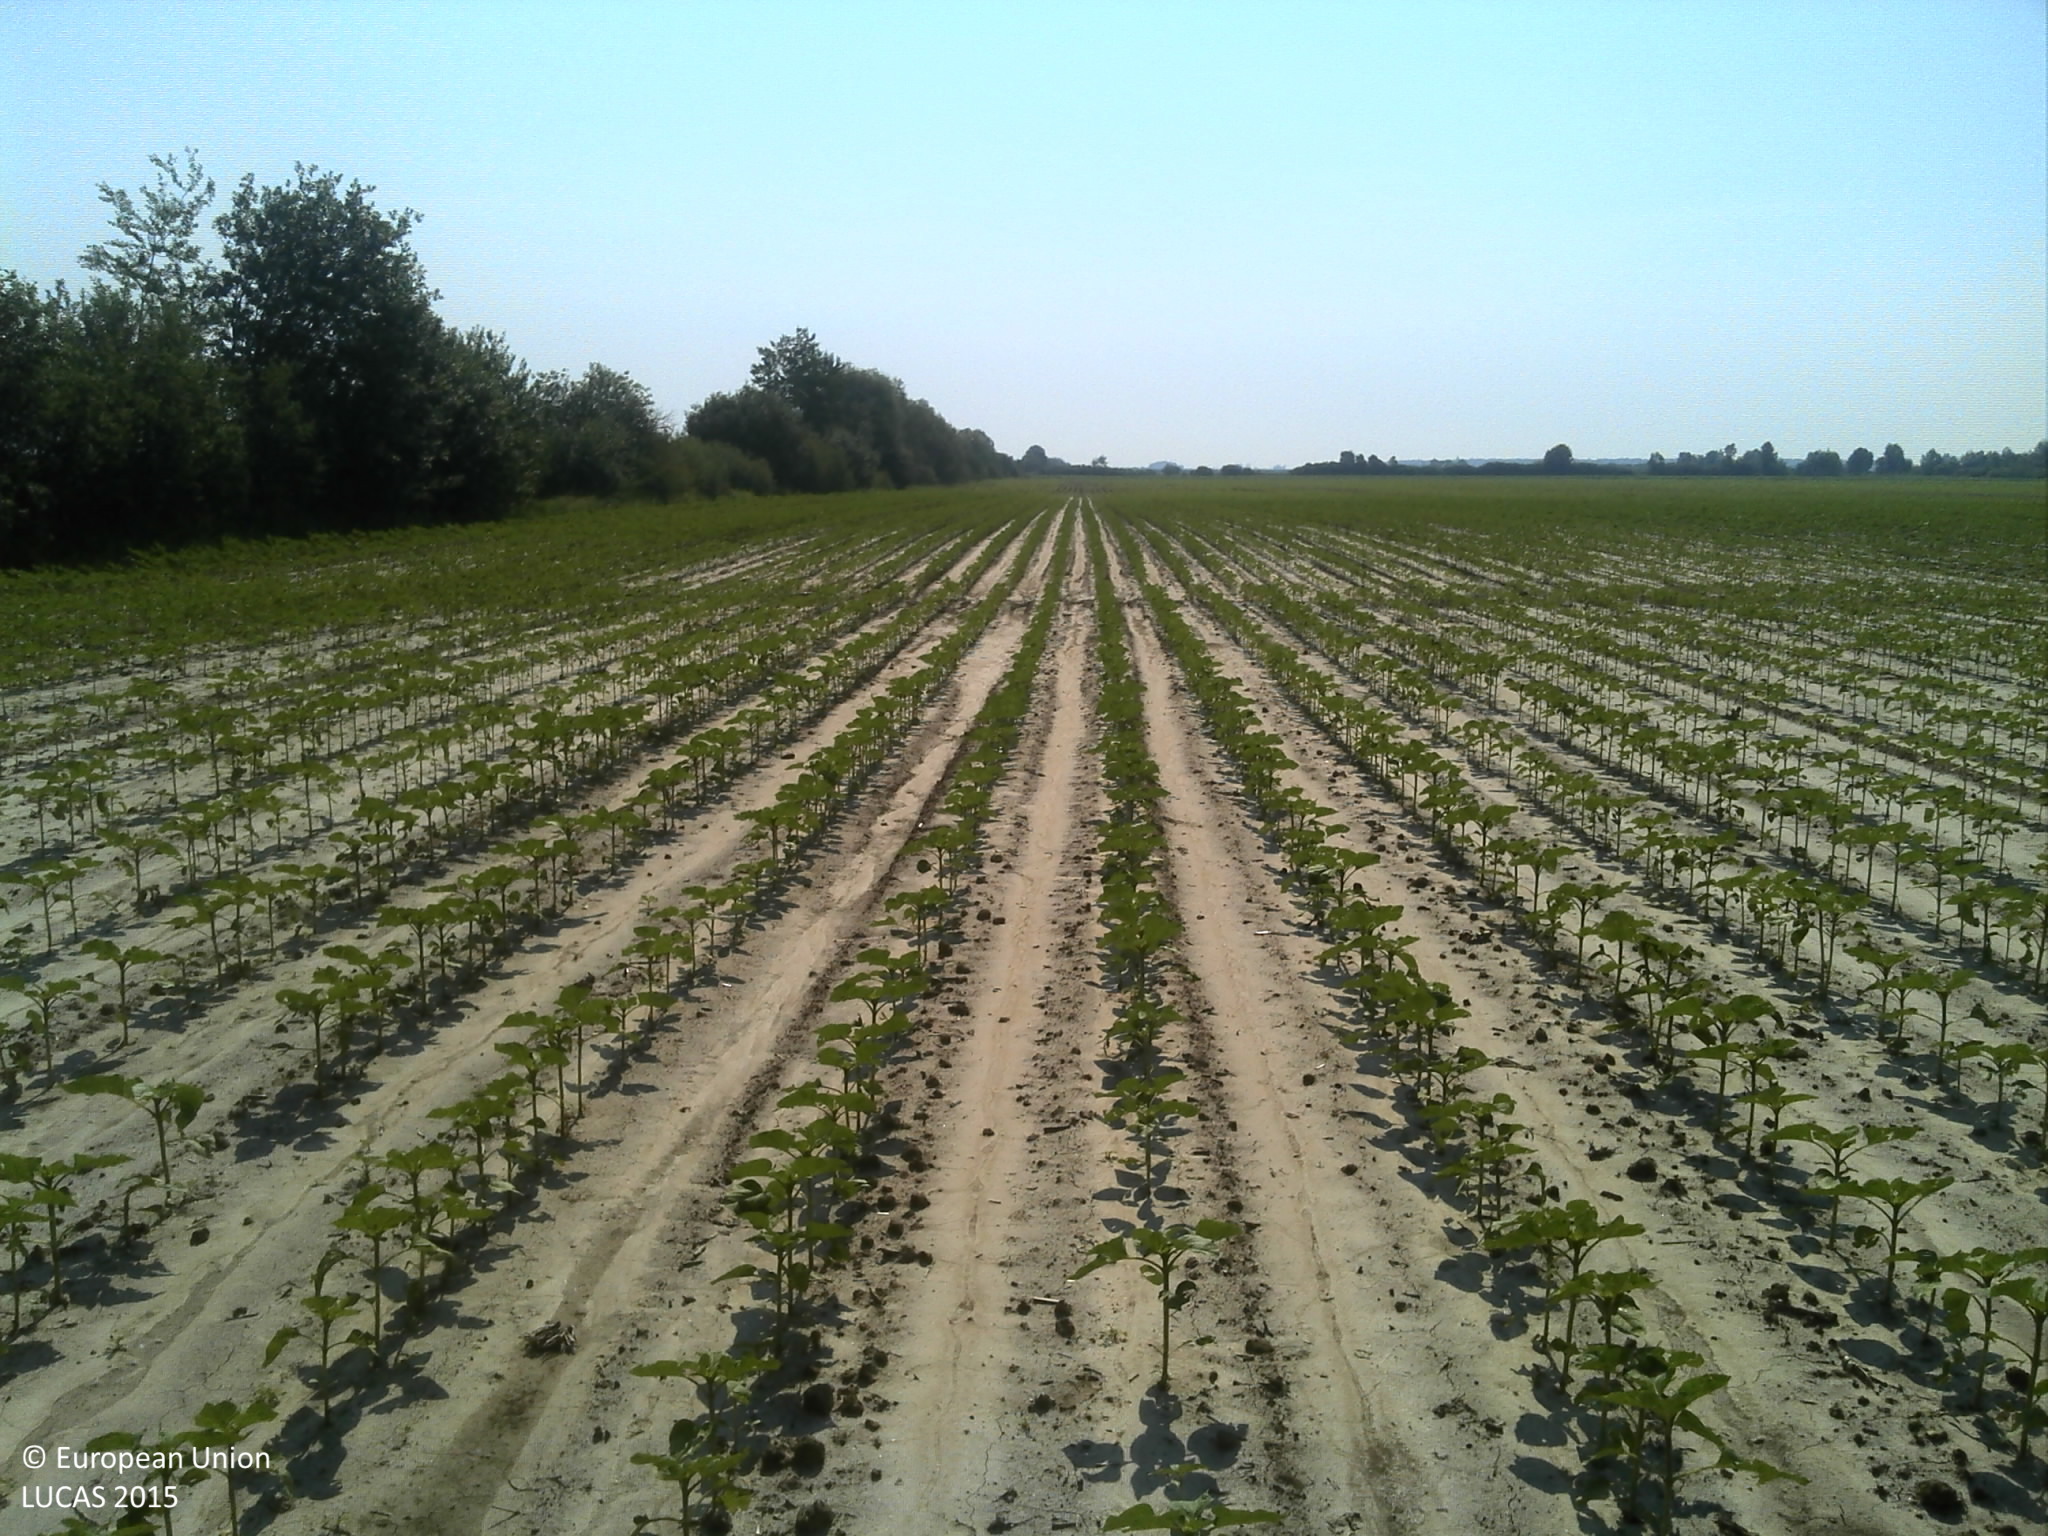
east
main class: Cropland
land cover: Soya
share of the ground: 10 - 25 %
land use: Agriculture (excluding fallow land and kitchen gardens)
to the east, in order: Soya; Ditches and canals; Tracks; Soya
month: June
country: HR
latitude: 45.6825
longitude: 17.8485
